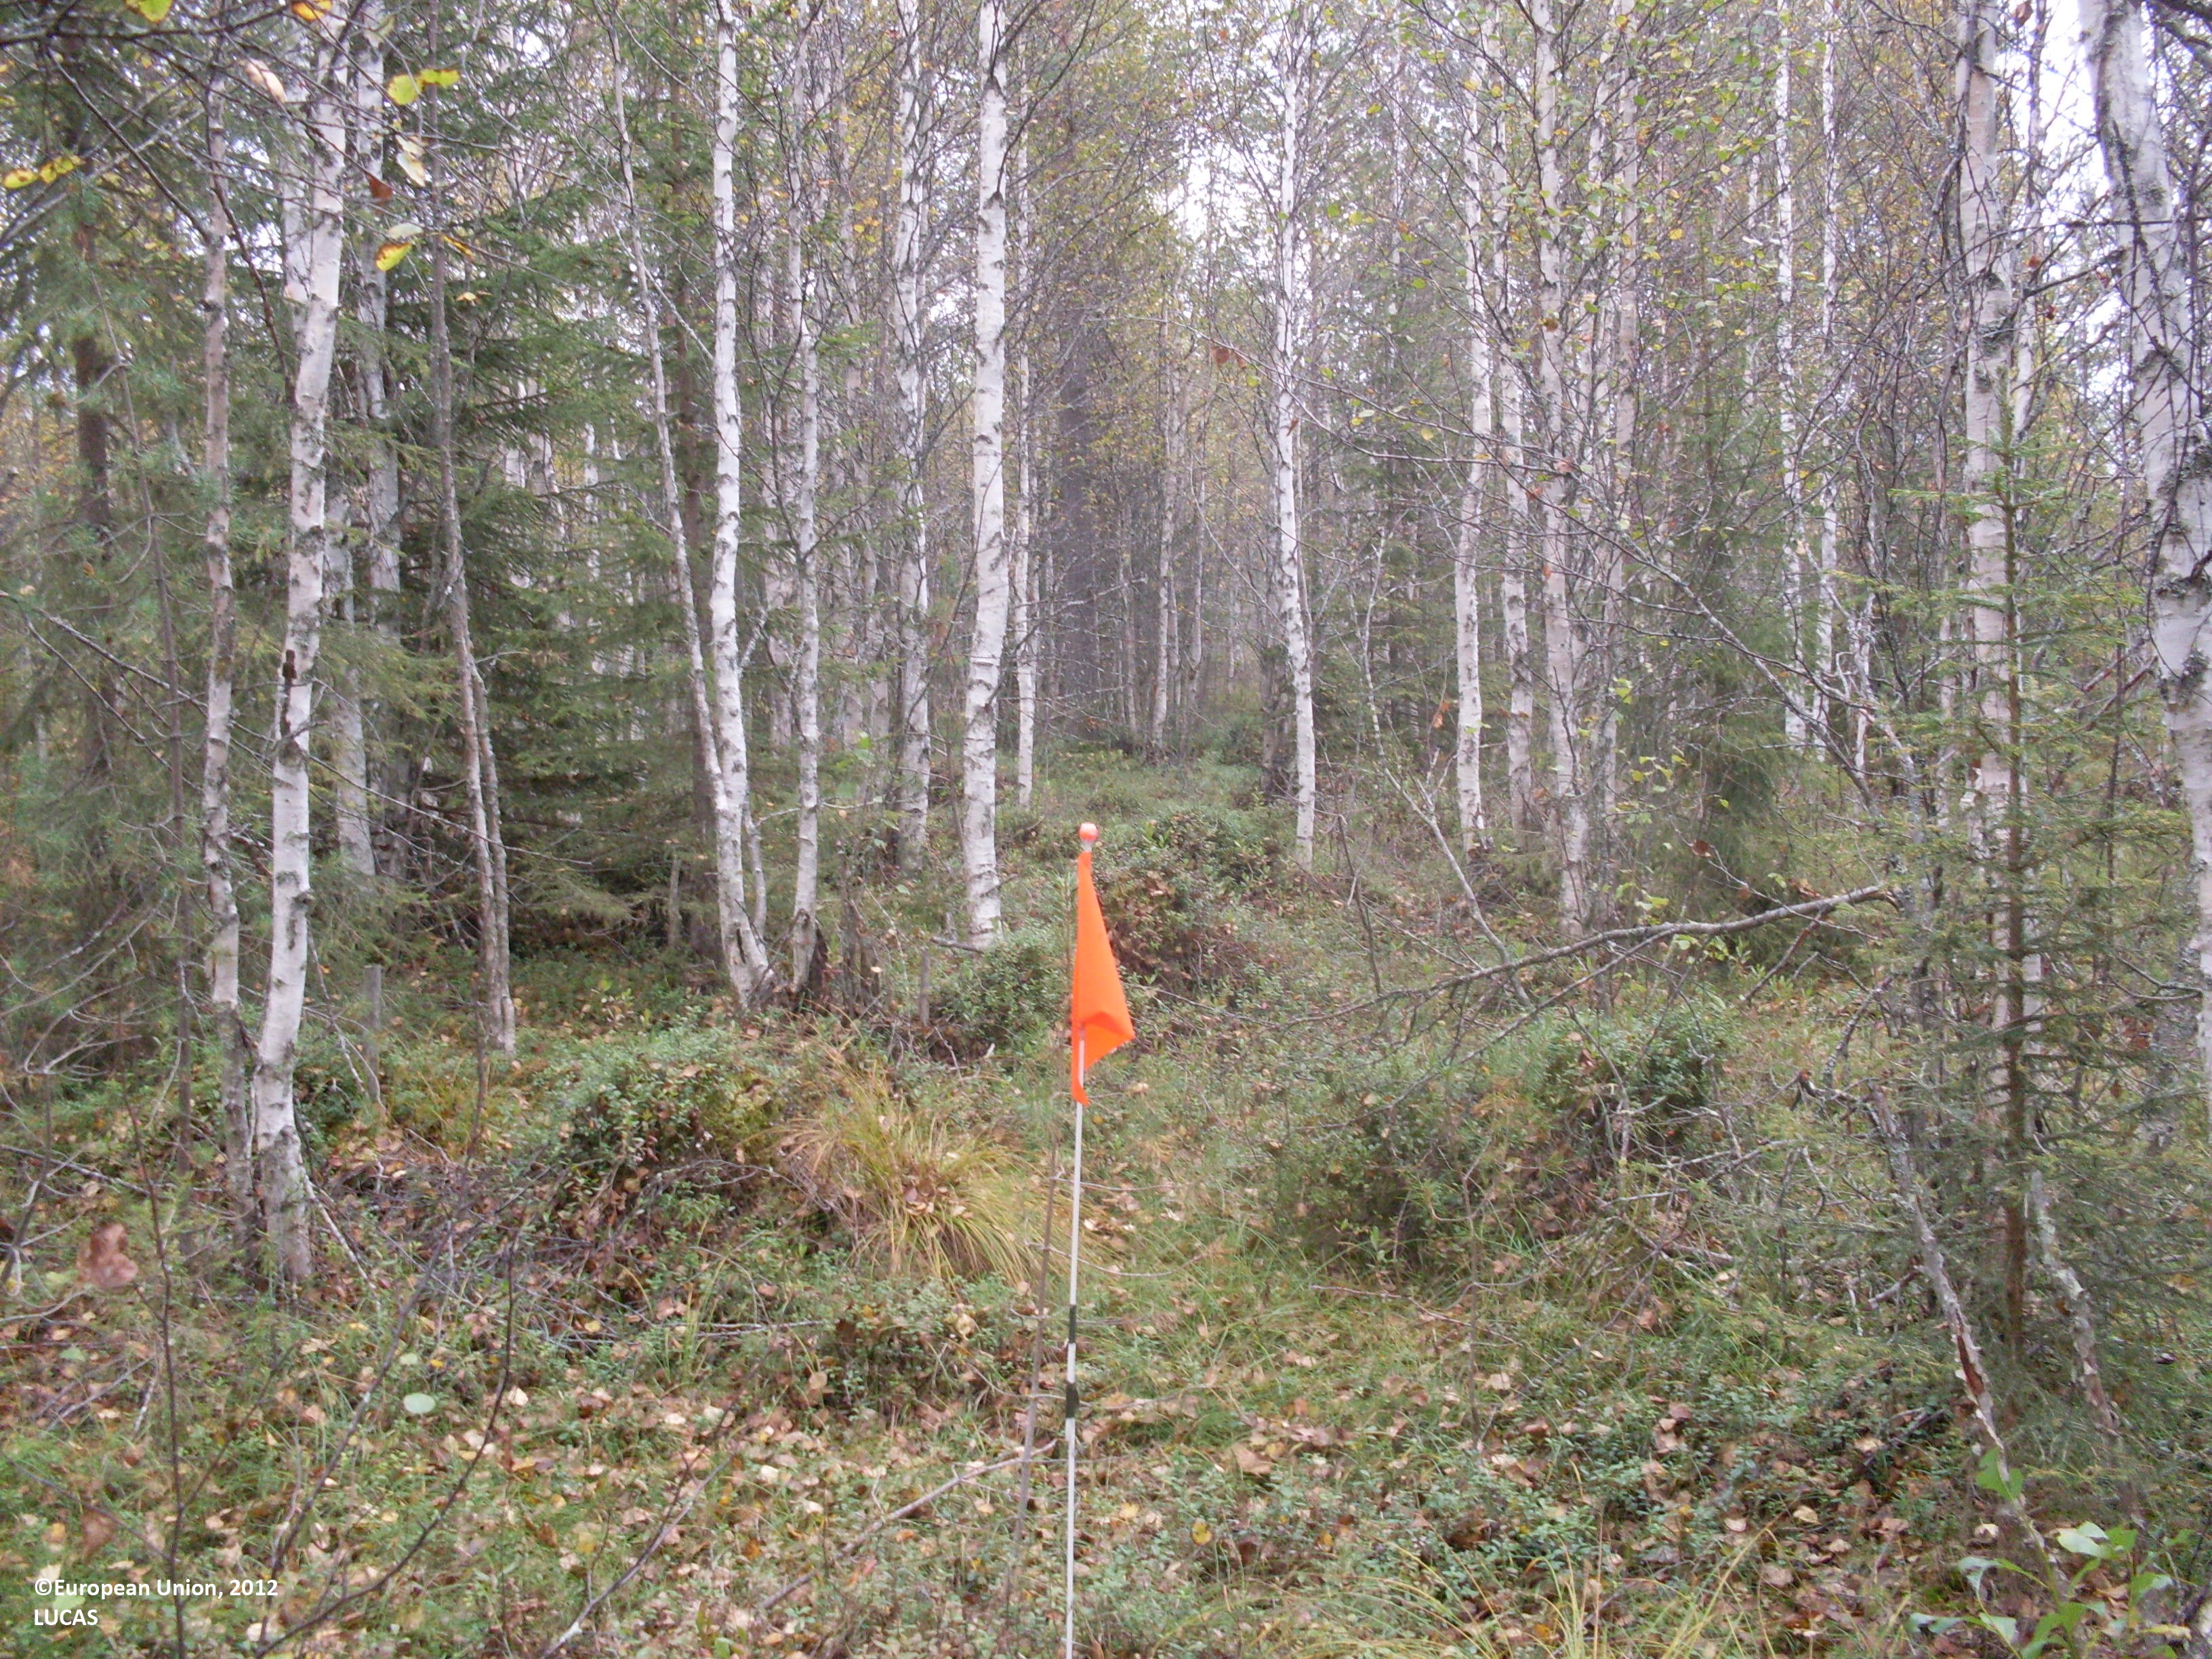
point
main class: Woodland
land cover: Other mixed woodland
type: boreal forest
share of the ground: 50 - 75 %
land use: Forestry
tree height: > 5 m
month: September
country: FI
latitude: 63.9750
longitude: 29.7814
